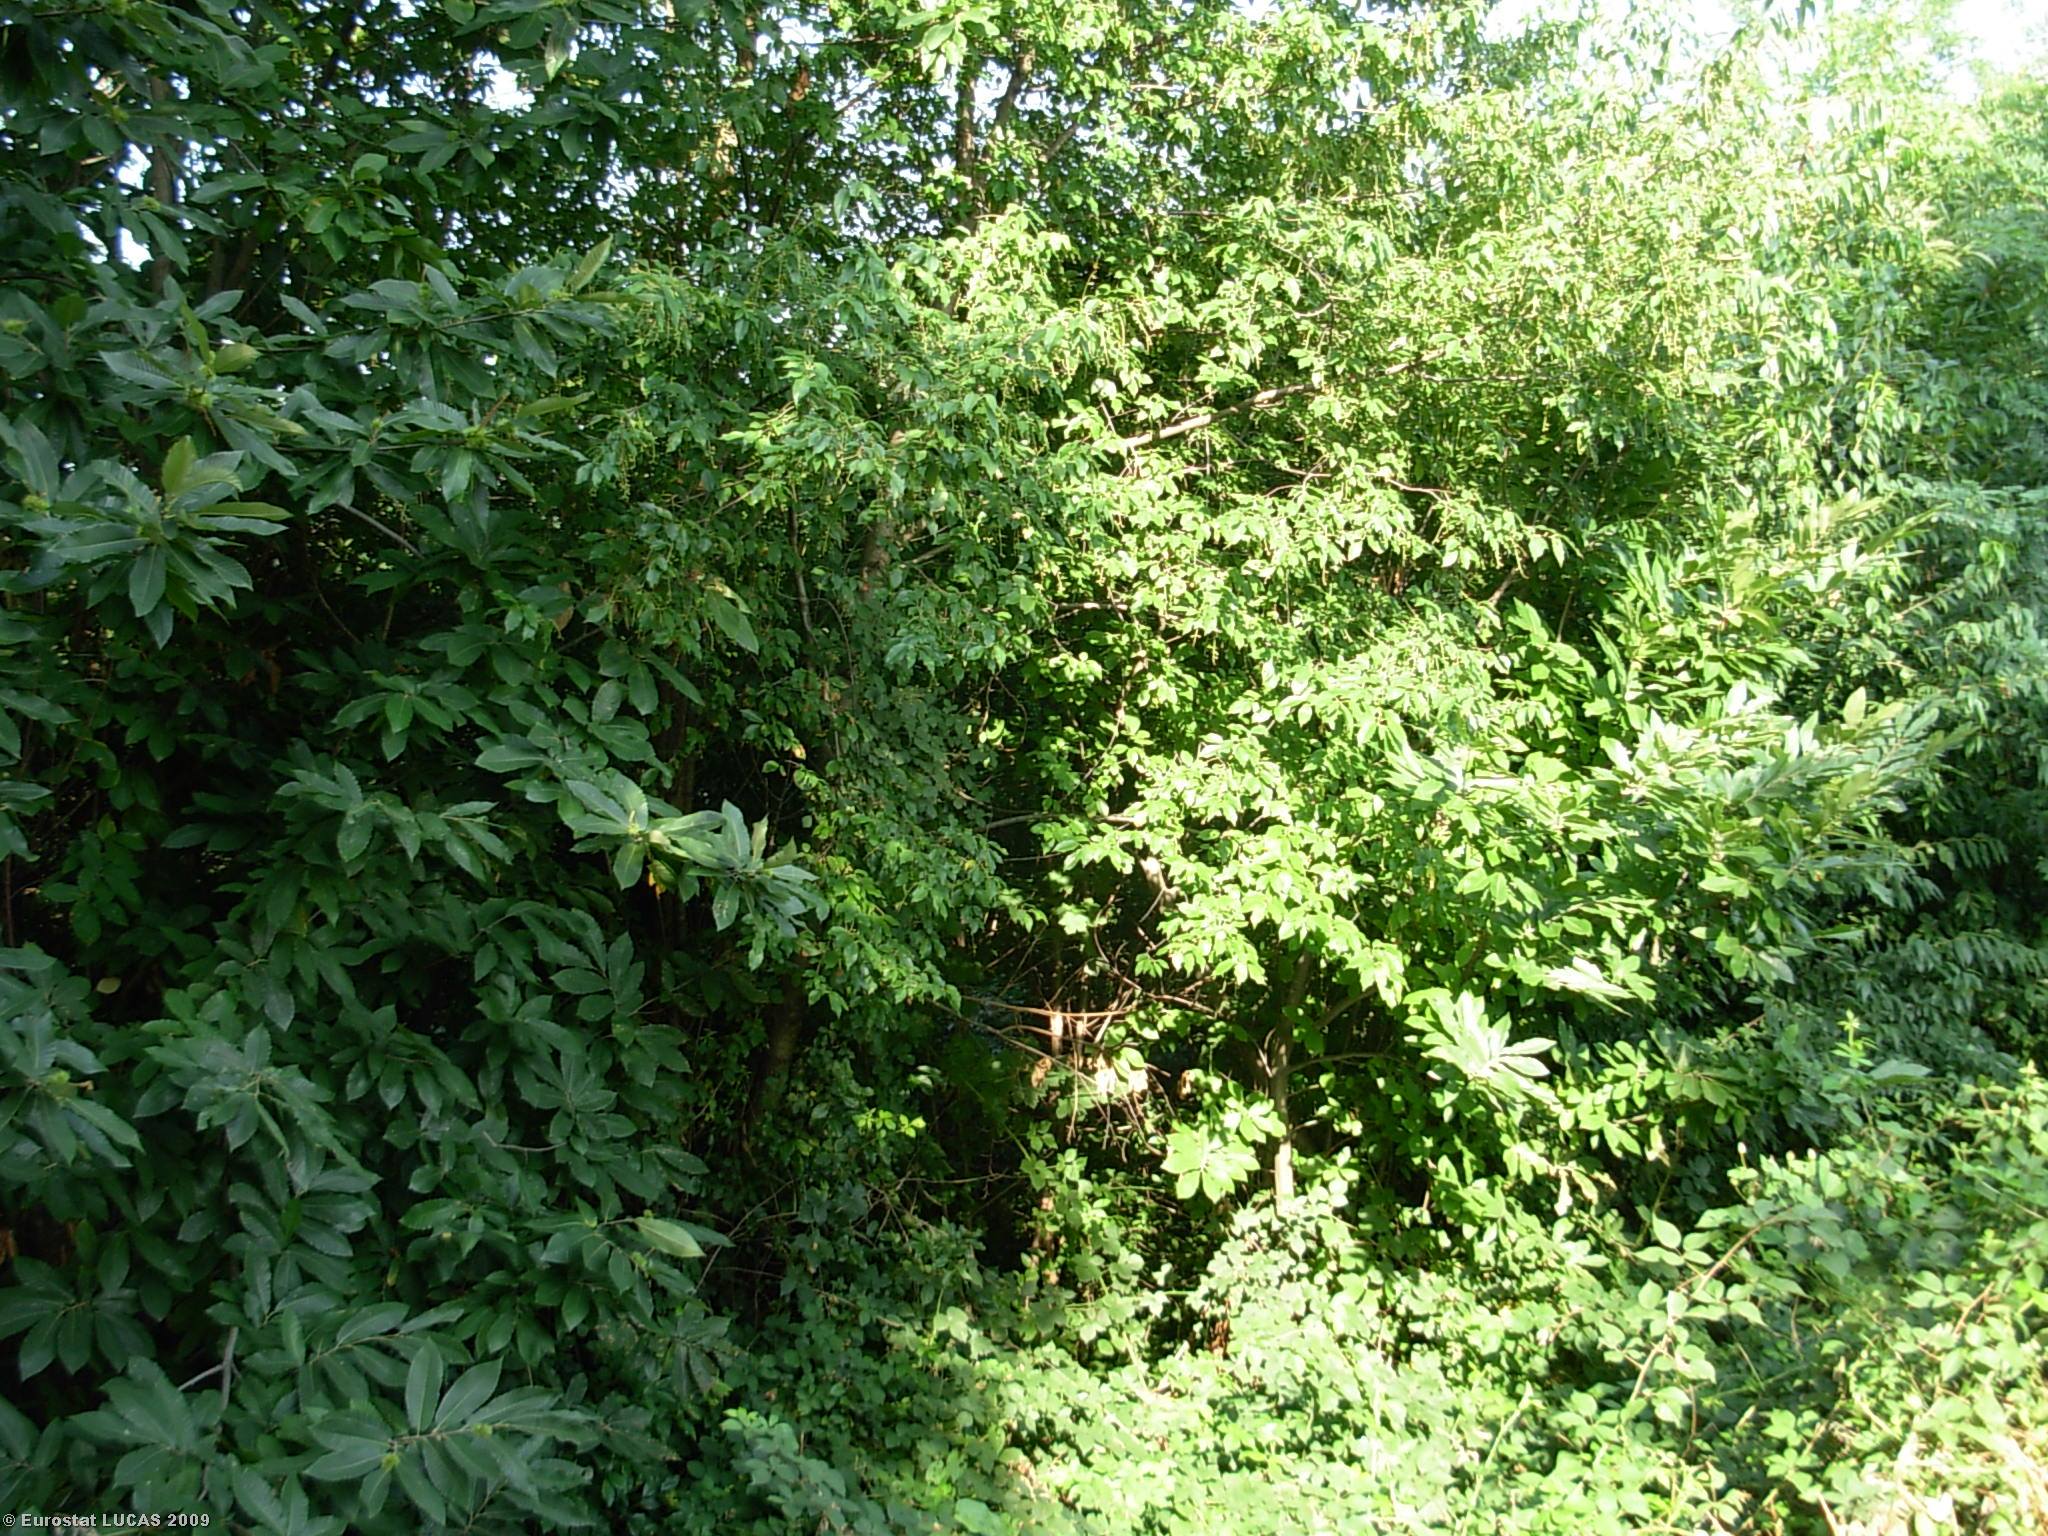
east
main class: Woodland
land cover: Broadleaved woodland
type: mesophytic deciduous forest
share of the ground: > 75 %
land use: Agriculture (excluding fallow land and kitchen gardens)
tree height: > 5 m
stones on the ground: < 10 %
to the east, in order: Broadleaved woodland; Shruby margins; Broadleaved woodland; Inland running water; Broadleaved woodland
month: July
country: IT
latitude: 45.6642
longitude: 9.2952
